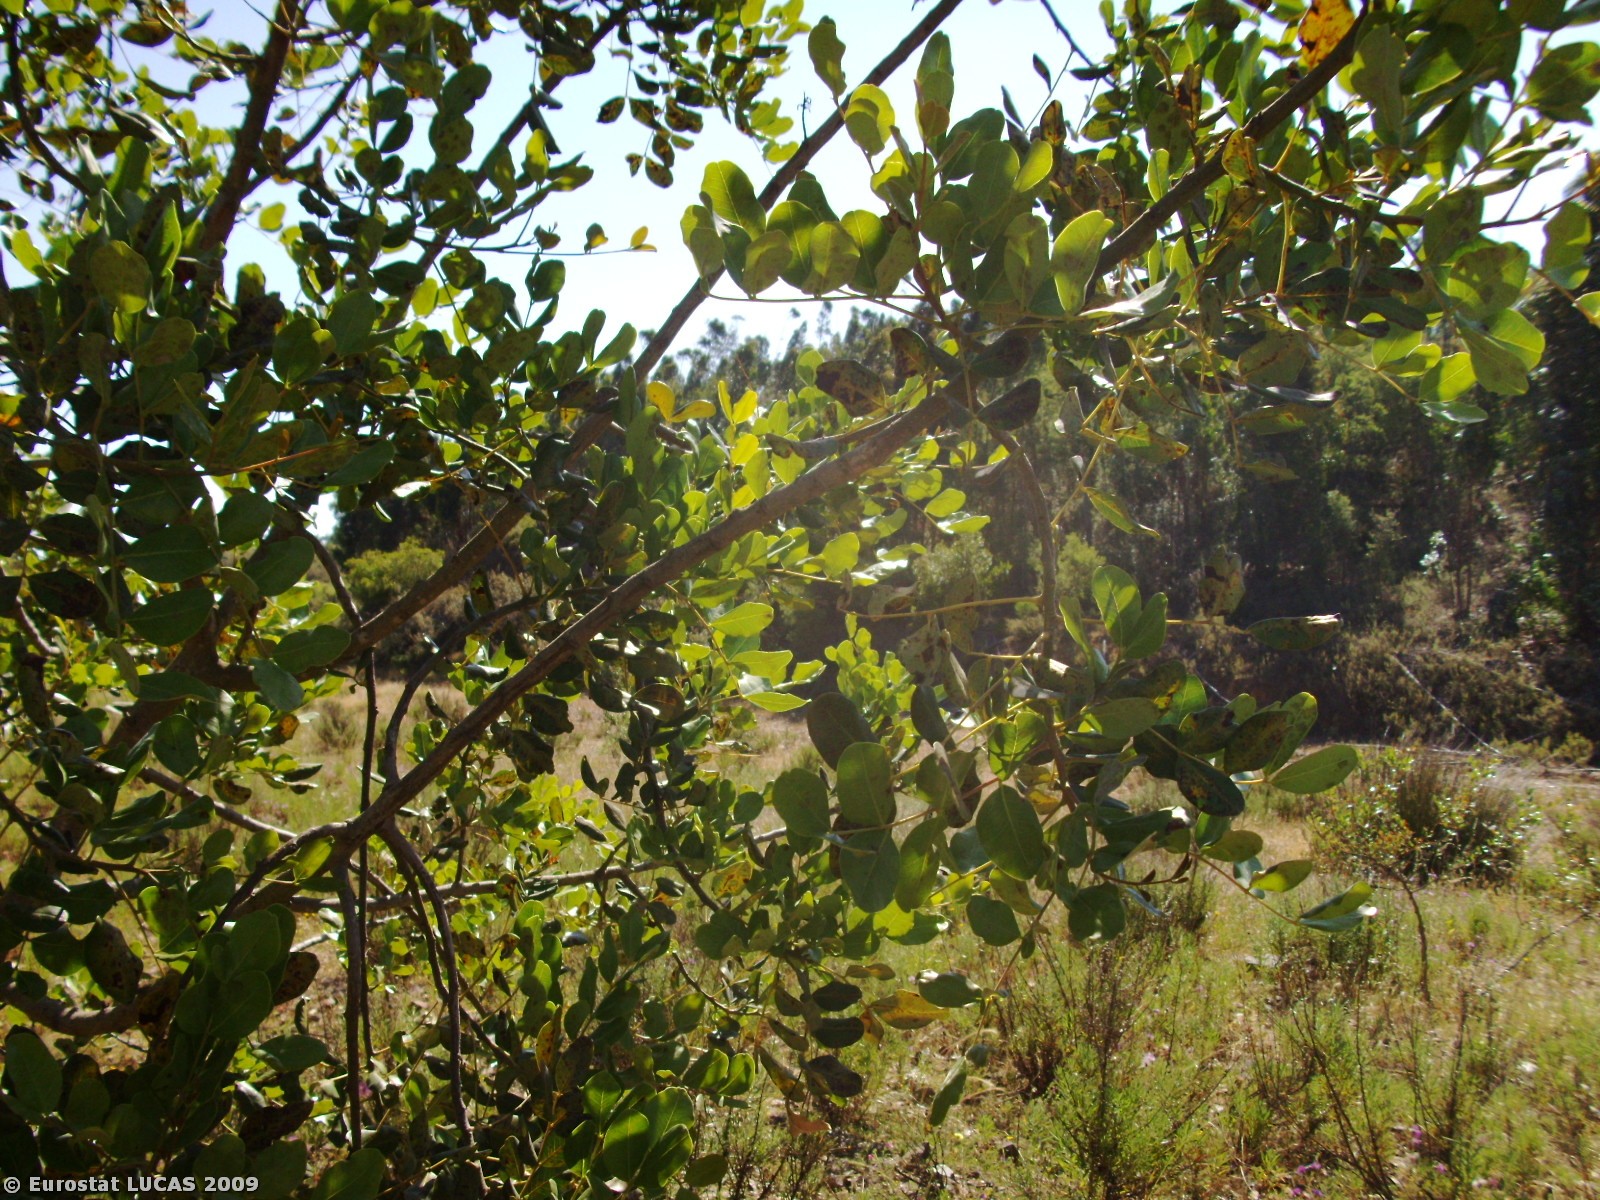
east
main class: Cropland
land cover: Permanent industrial crops
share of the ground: 10 - 25 %
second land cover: Spontaneously vegetated surfaces
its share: 25 - 50 %
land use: Agriculture (excluding fallow land and kitchen gardens)
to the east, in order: Permanent industrial crops; Spontaneously vegetated surfaces; Permanent industrial crops; Grass margins; Ditches and canals; Permanent industrial crops; Grass margins; Ditches and canals; Grass margins; Tracks; Broadleaved woodland
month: May
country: PT
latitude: 37.2789
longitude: -8.2589
